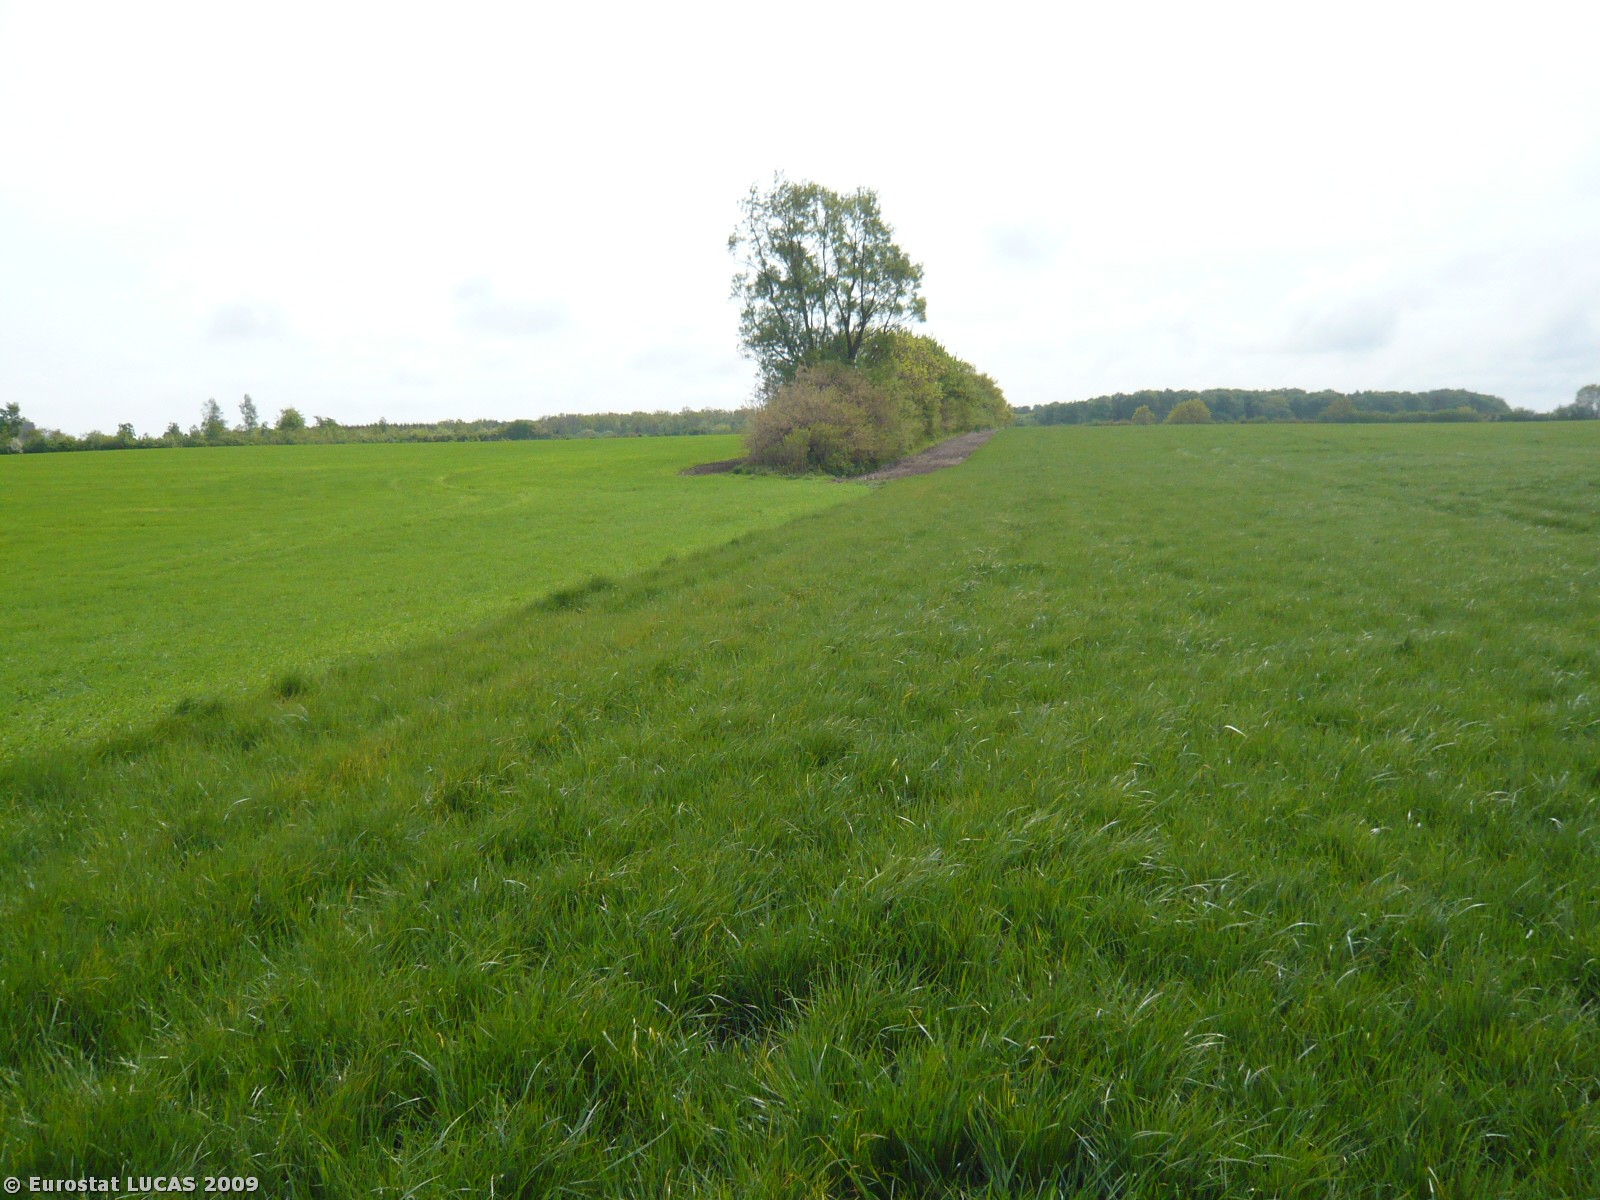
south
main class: Grassland
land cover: Grassland without tree/shrub cover
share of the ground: > 75 %
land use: Agriculture (excluding fallow land and kitchen gardens)
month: May
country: DK
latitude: 55.2537
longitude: 12.0909
